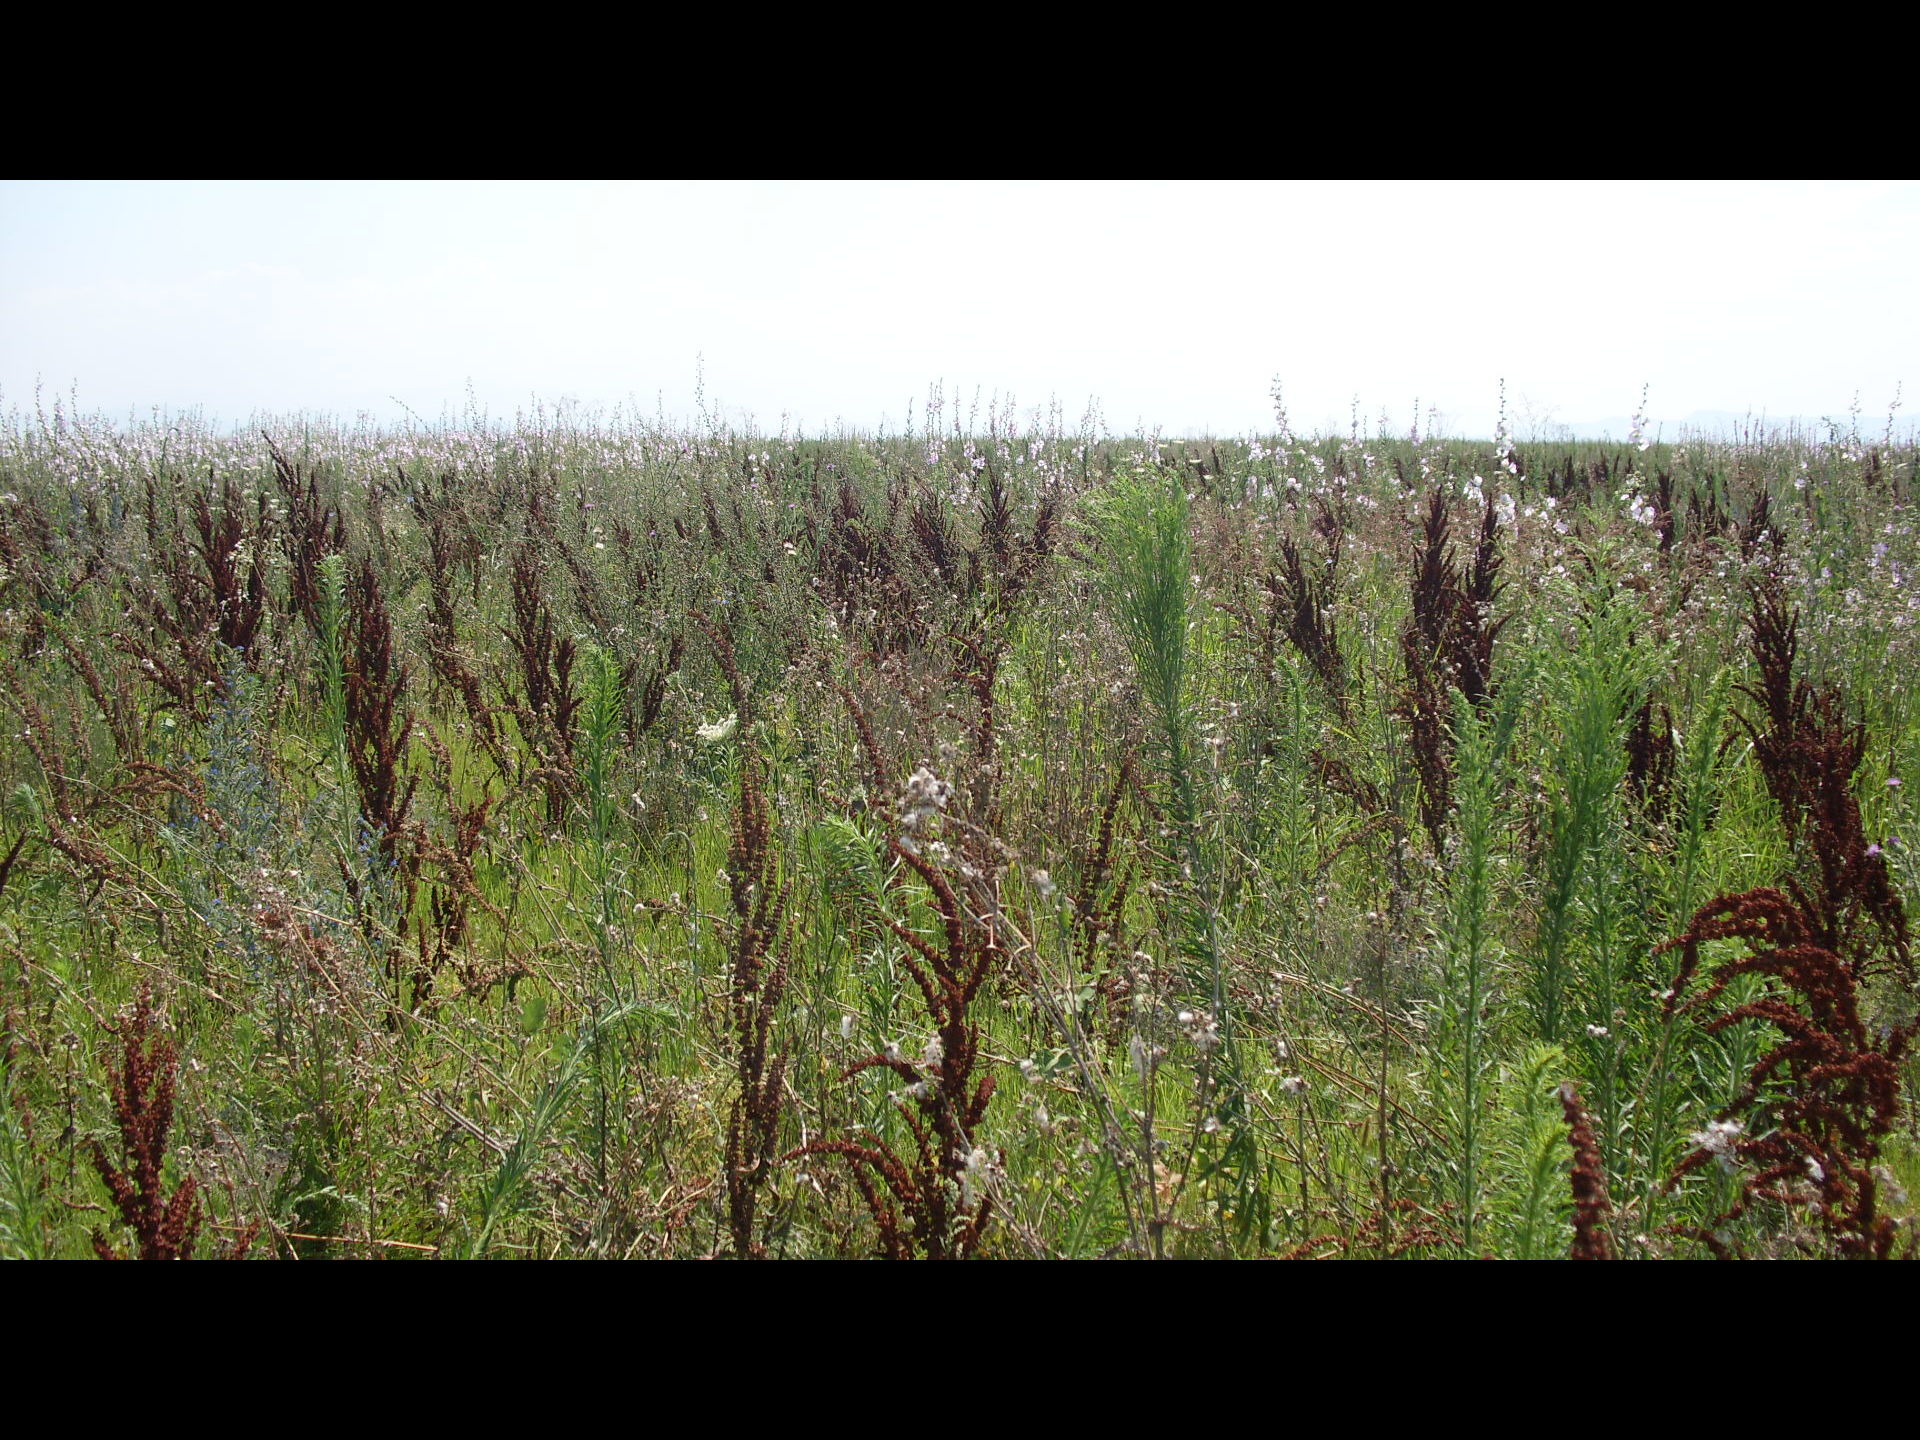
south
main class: Grassland
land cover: Spontaneously vegetated surfaces
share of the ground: > 75 %
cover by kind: herbaceous plants 100 %
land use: Fallow land
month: July
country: BG
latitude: 43.7228
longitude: 22.9103
